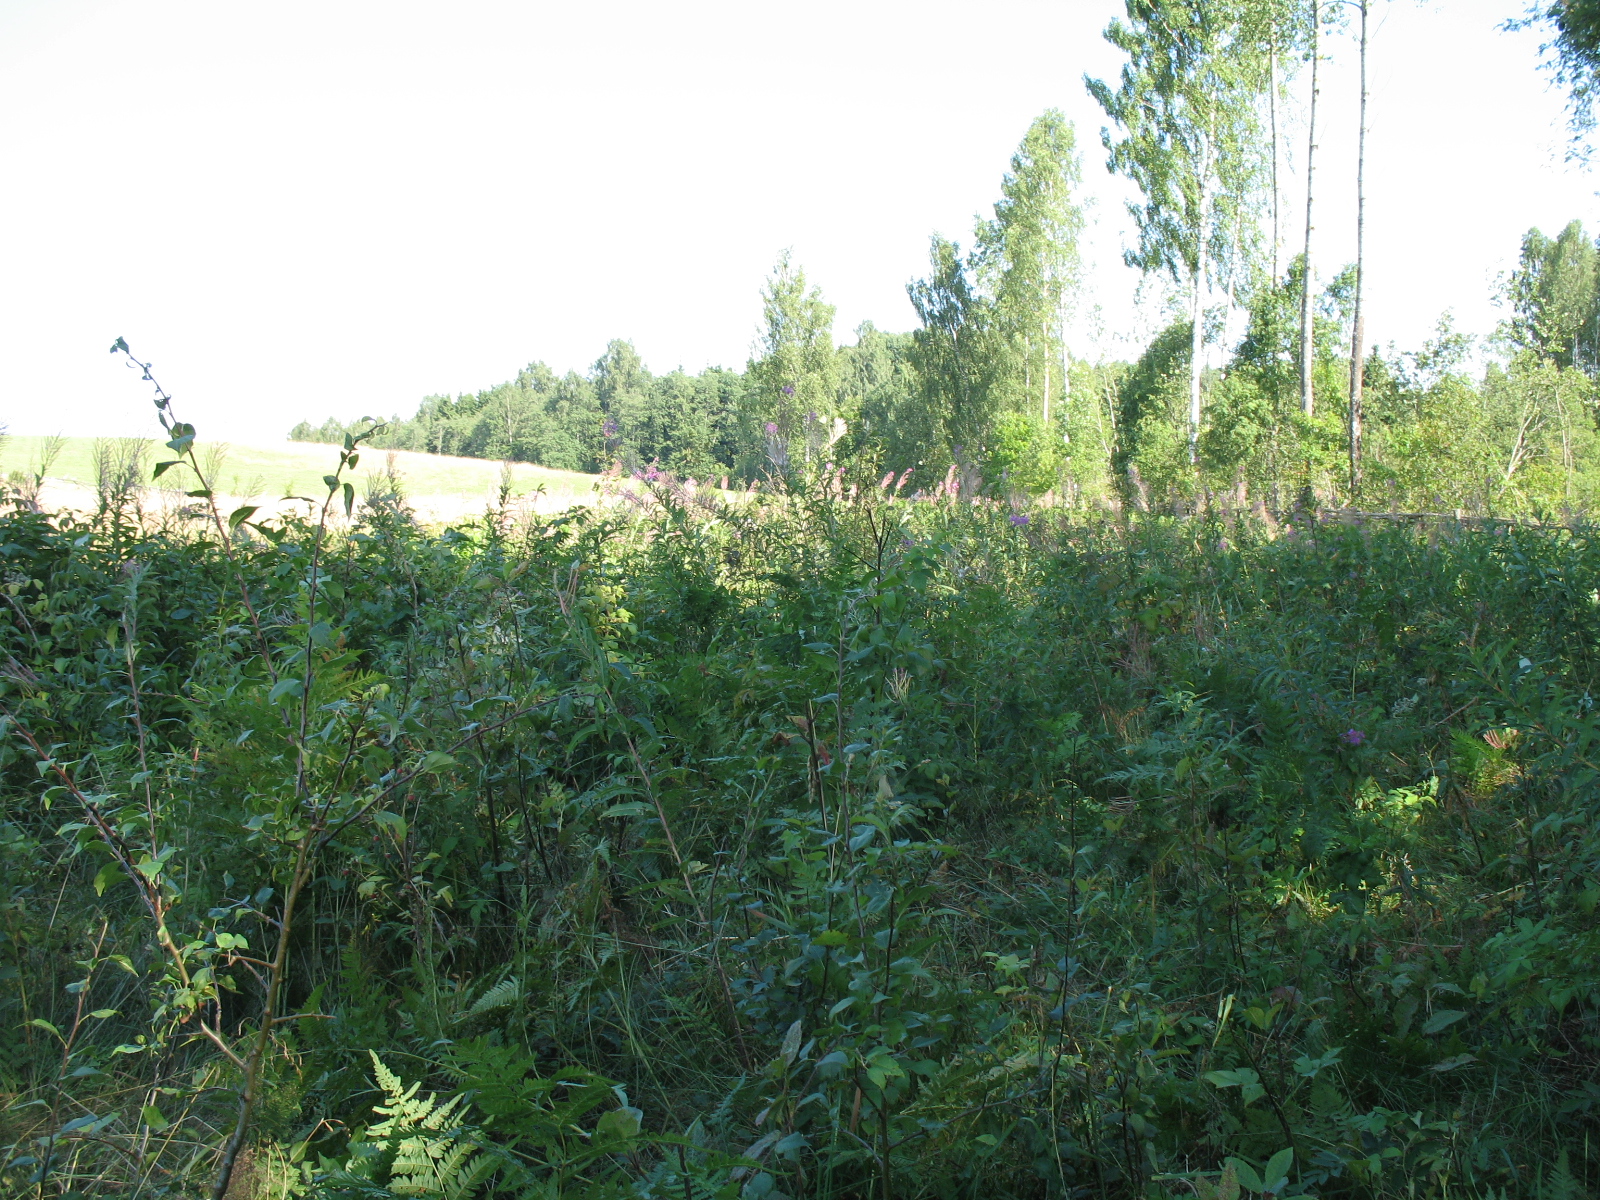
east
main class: Grassland
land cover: Spontaneously vegetated surfaces
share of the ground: > 75 %
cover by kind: herbaceous plants 100 %
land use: Agriculture (excluding fallow land and kitchen gardens)
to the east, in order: Spontaneously vegetated surfaces; Grassland without tree/shrub cover; Fences; Spontaneously vegetated surfaces; Grassland without tree/shrub cover
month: August
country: LV
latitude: 56.5513
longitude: 25.2586
